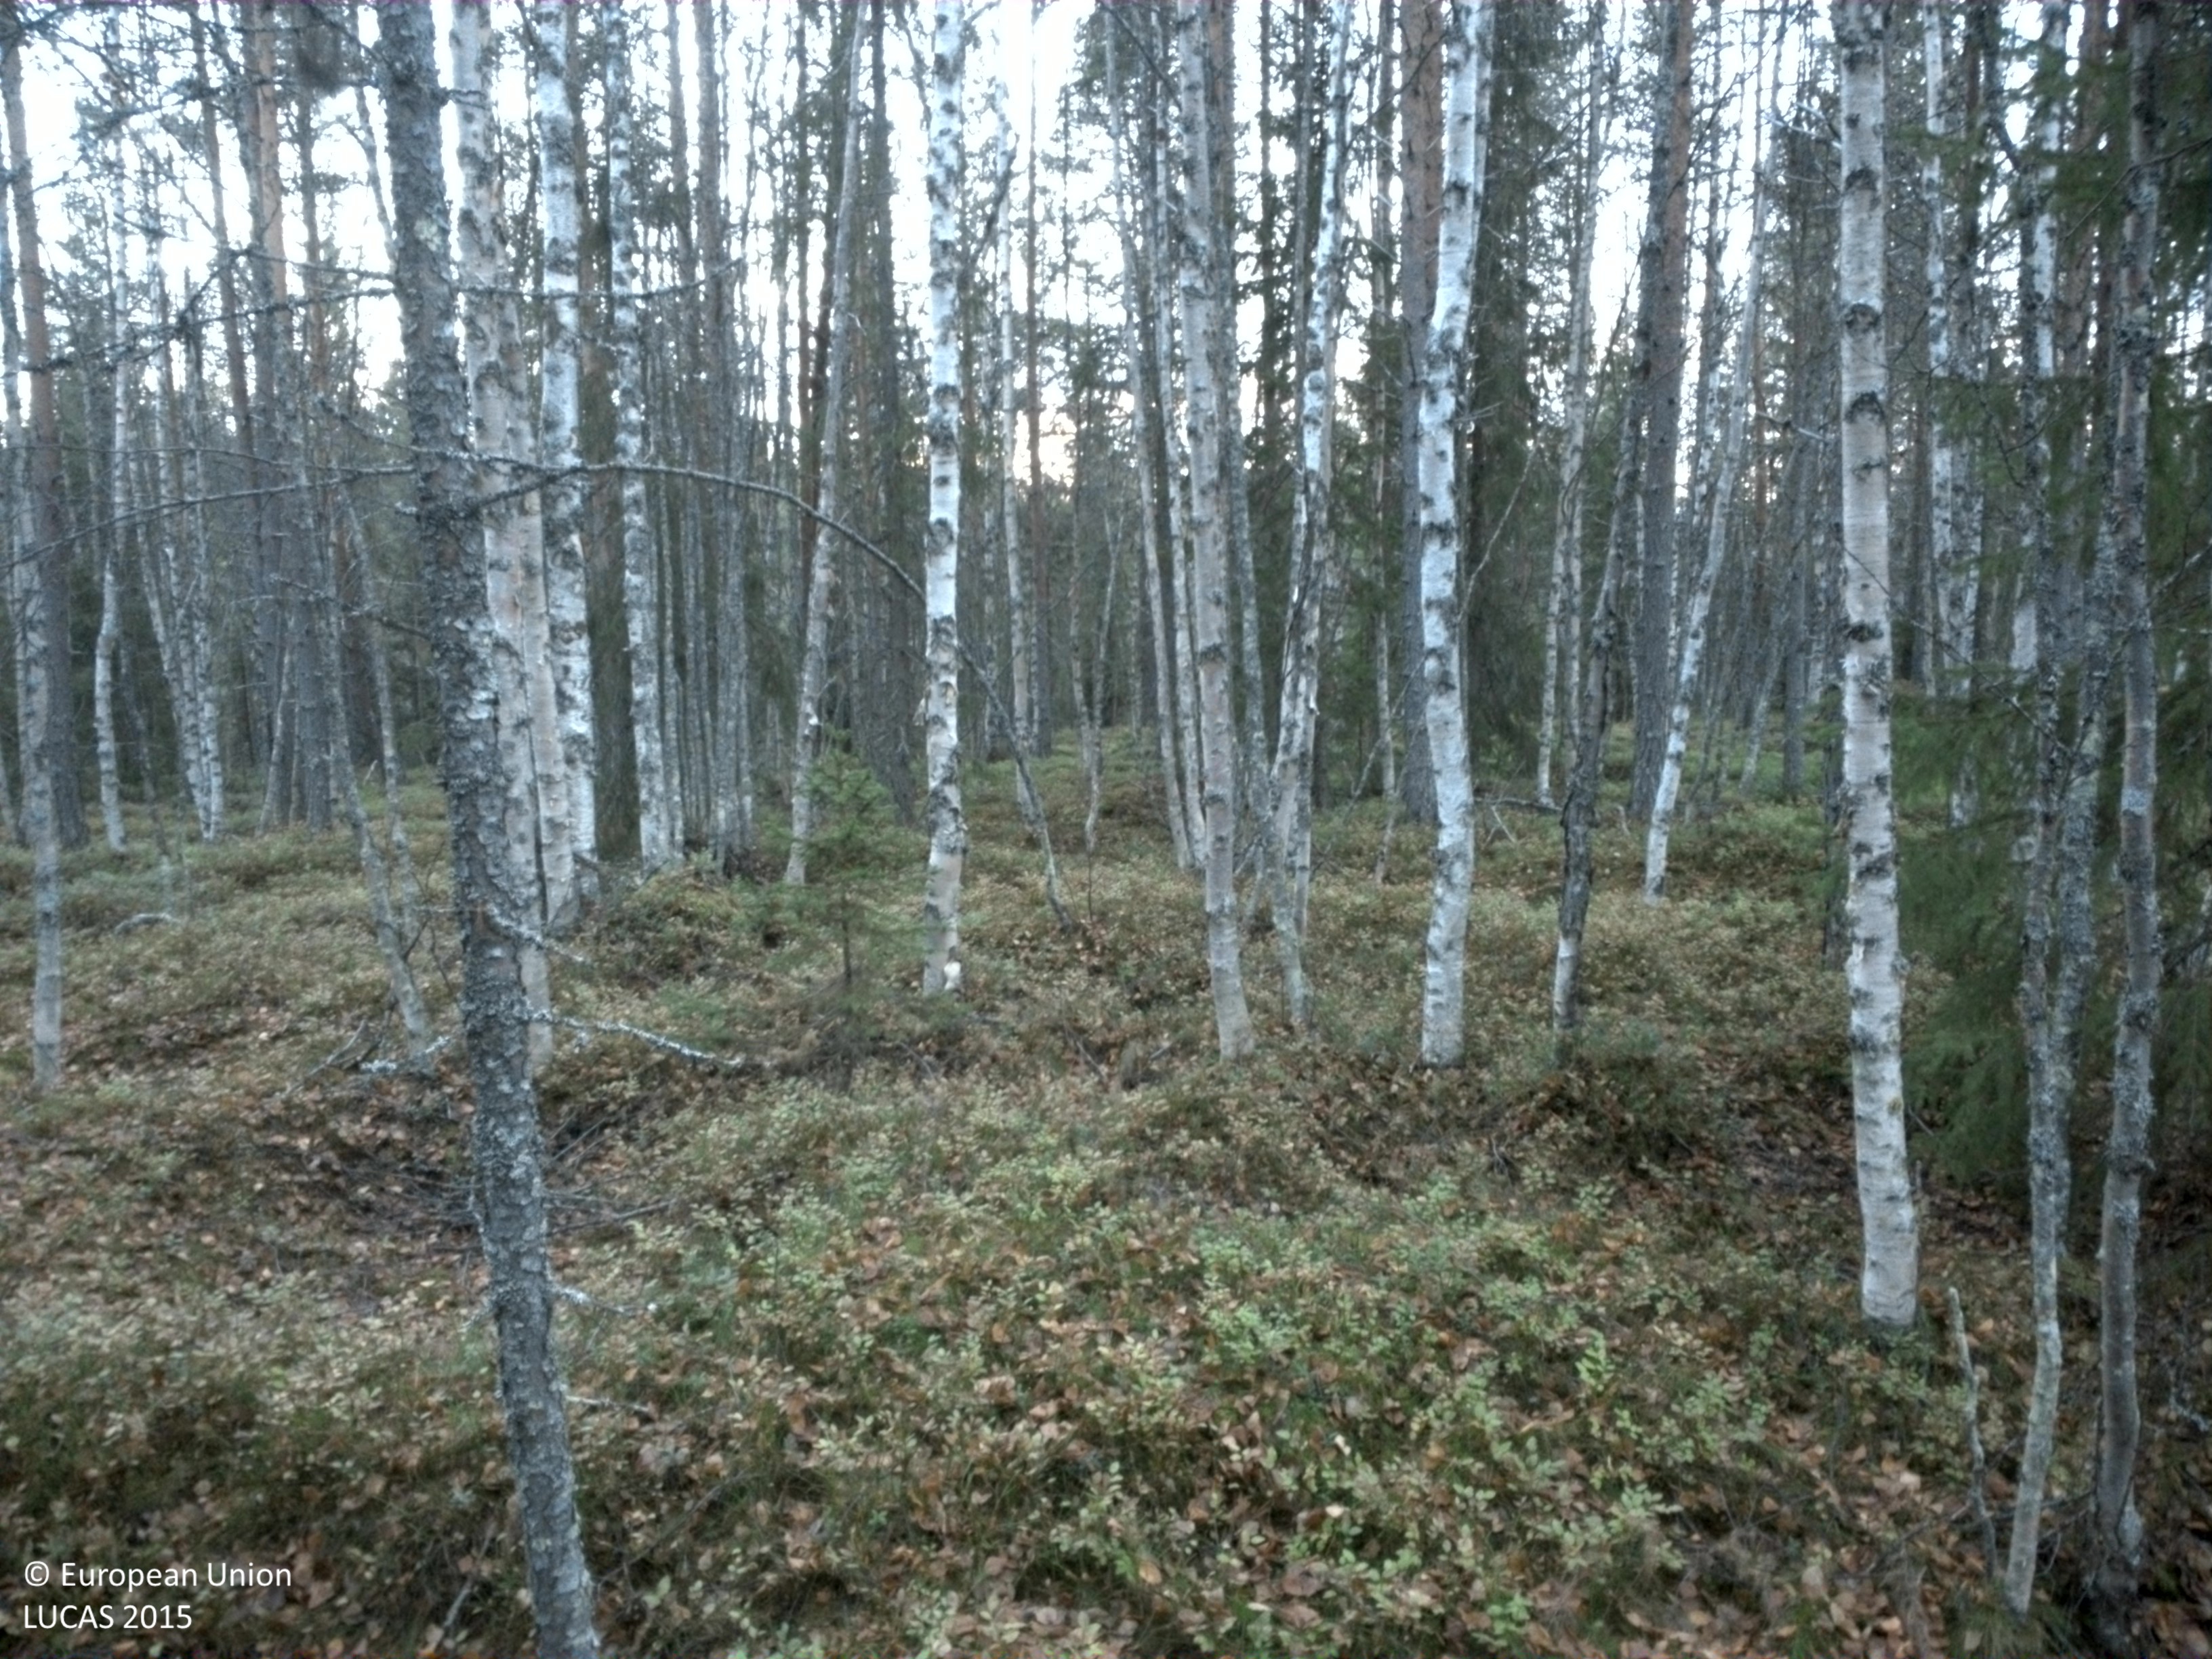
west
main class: Woodland
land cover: Other mixed woodland
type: boreal forest
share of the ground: 50 - 75 %
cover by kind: broadleaved forest trees 35 %, coniferous forest trees 25 %, shrubs 25 %, lichens and mosses 10 %, herbaceous plants 5 %
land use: Forestry
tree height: > 5 m
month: October
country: SE
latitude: 64.5927
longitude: 16.4639
